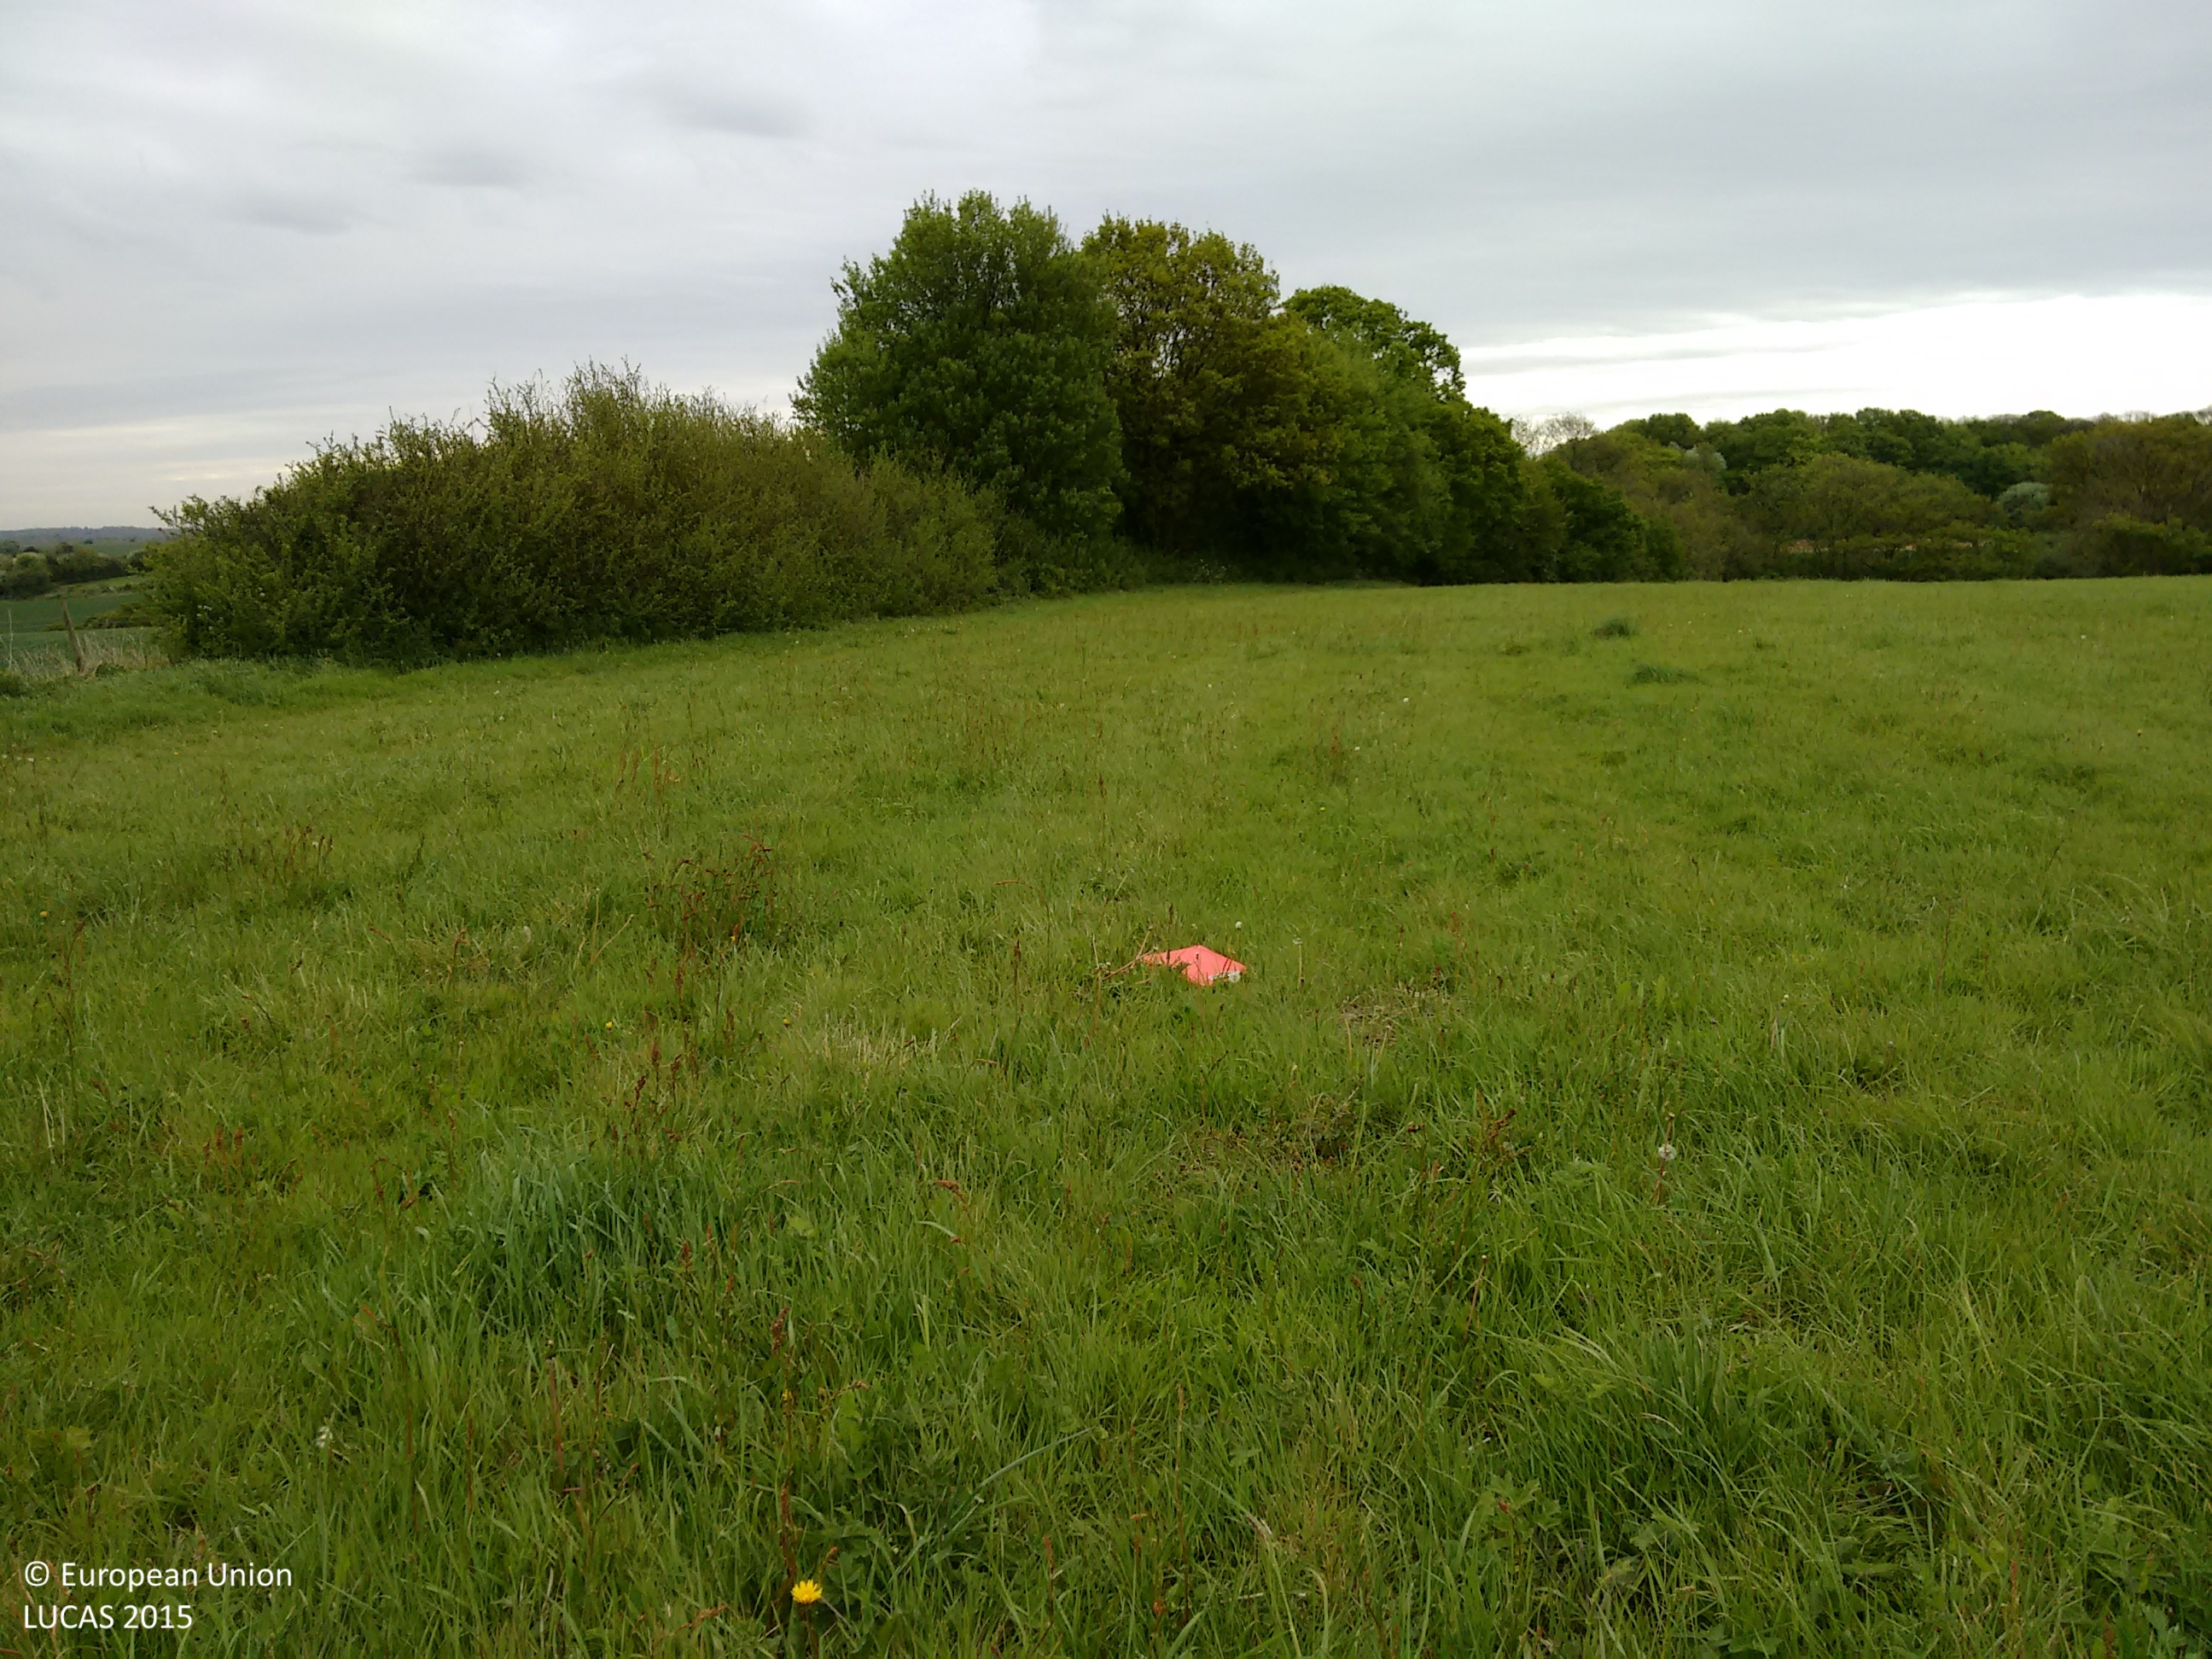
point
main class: Grassland
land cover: Grassland without tree/shrub cover
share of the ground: > 75 %
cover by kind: herbaceous plants 100 %
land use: Agriculture (excluding fallow land and kitchen gardens)
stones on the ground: < 10 %
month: May
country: GB
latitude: 51.3663
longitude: 0.3327
